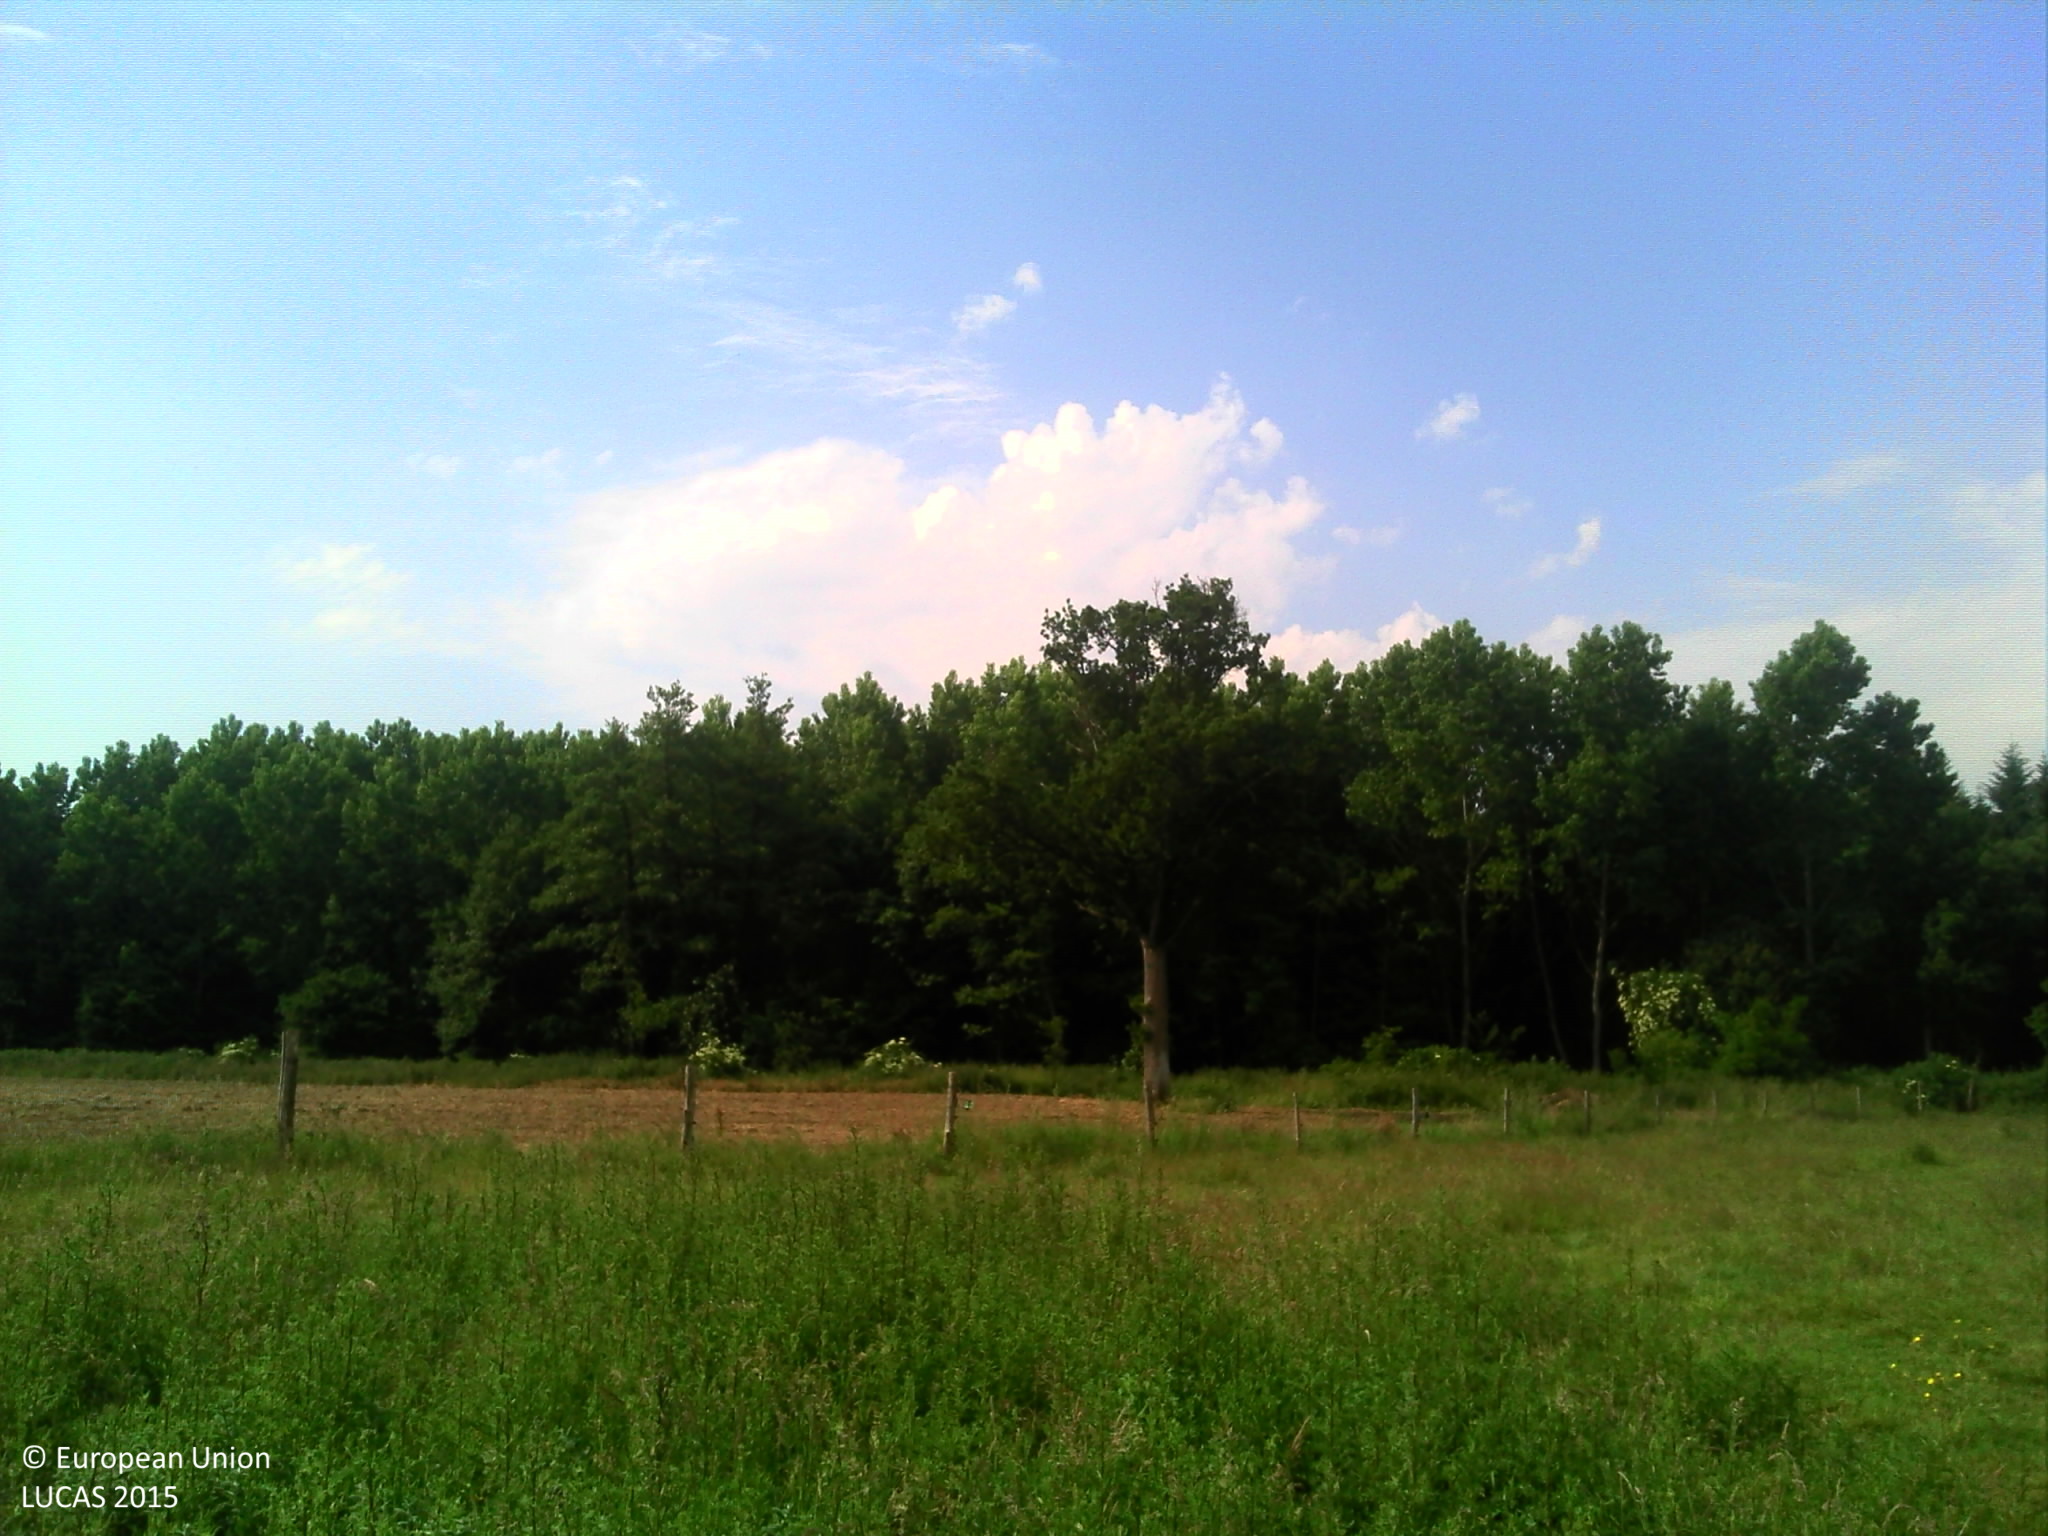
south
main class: Grassland
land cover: Grassland without tree/shrub cover
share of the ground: > 75 %
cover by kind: herbaceous plants 100 %
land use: Agriculture (excluding fallow land and kitchen gardens)
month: June
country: FR
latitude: 47.8929
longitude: -0.0189
